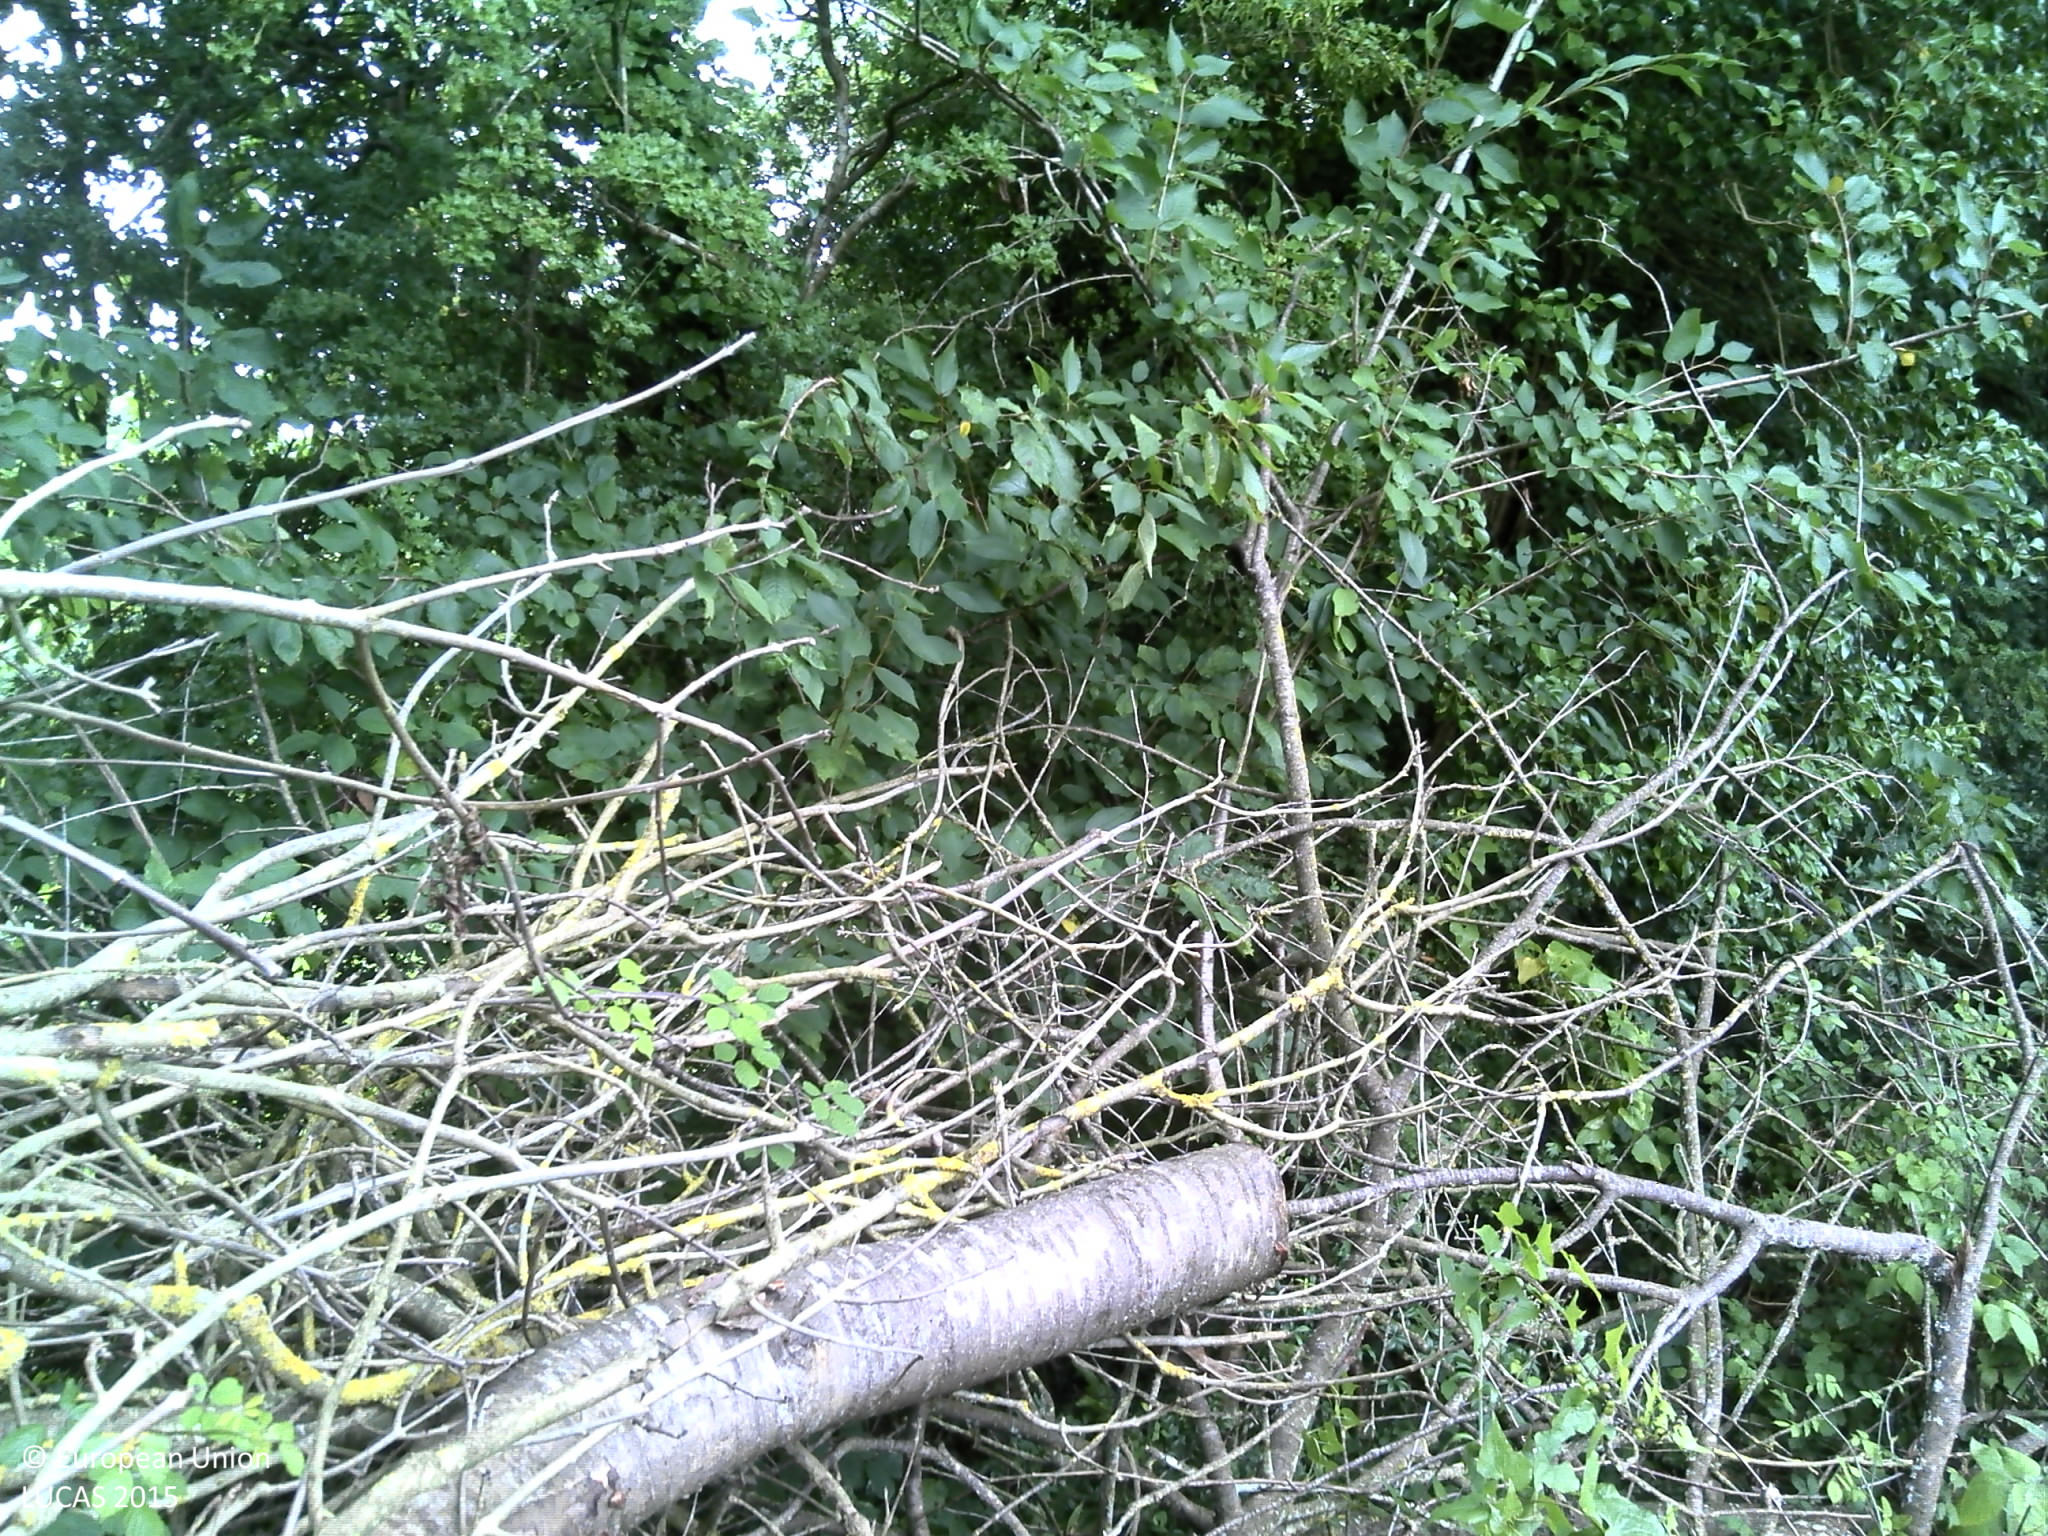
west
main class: Woodland
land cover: Broadleaved woodland
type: mesophytic deciduous forest
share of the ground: > 75 %
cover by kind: broadleaved forest trees 100 %
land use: Agriculture (excluding fallow land and kitchen gardens)
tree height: > 5 m
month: July
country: FR
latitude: 48.2846
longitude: -4.2019
